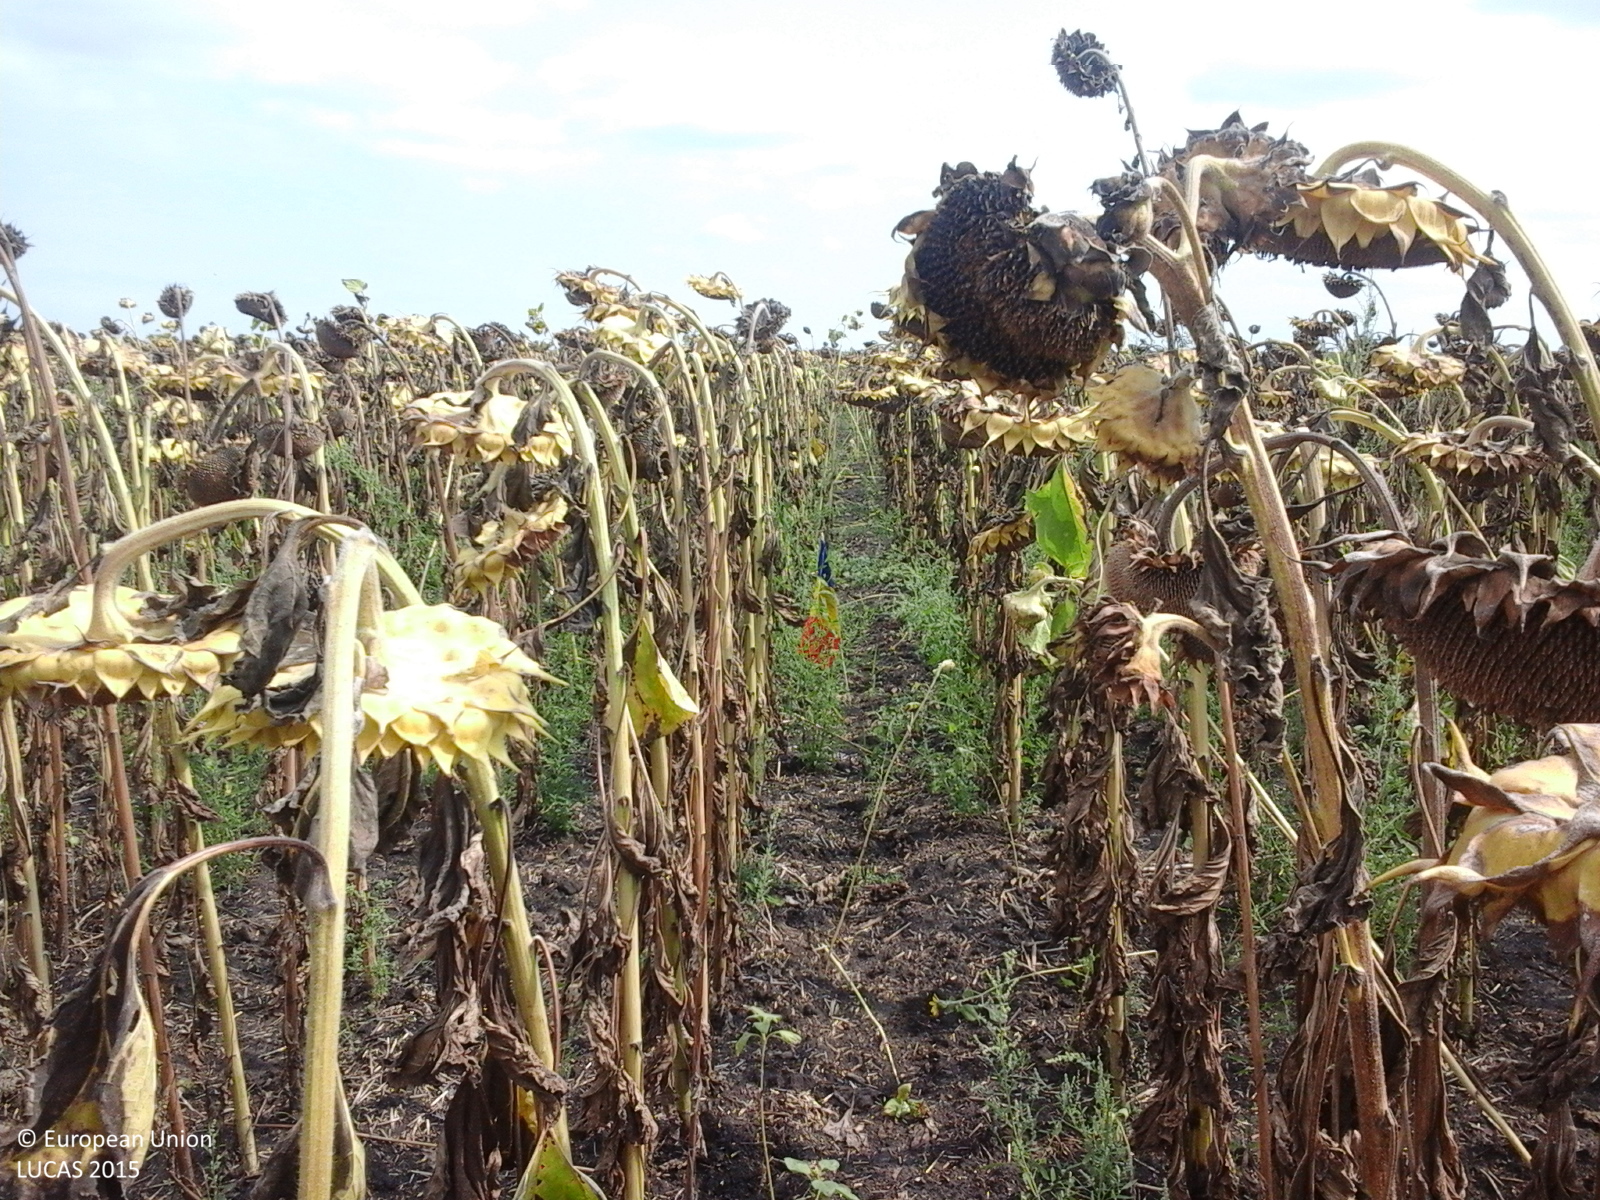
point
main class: Cropland
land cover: Sunflower
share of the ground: > 75 %
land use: Agriculture (excluding fallow land and kitchen gardens)
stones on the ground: < 10 %
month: August
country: RO
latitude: 45.4796
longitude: 20.9383
